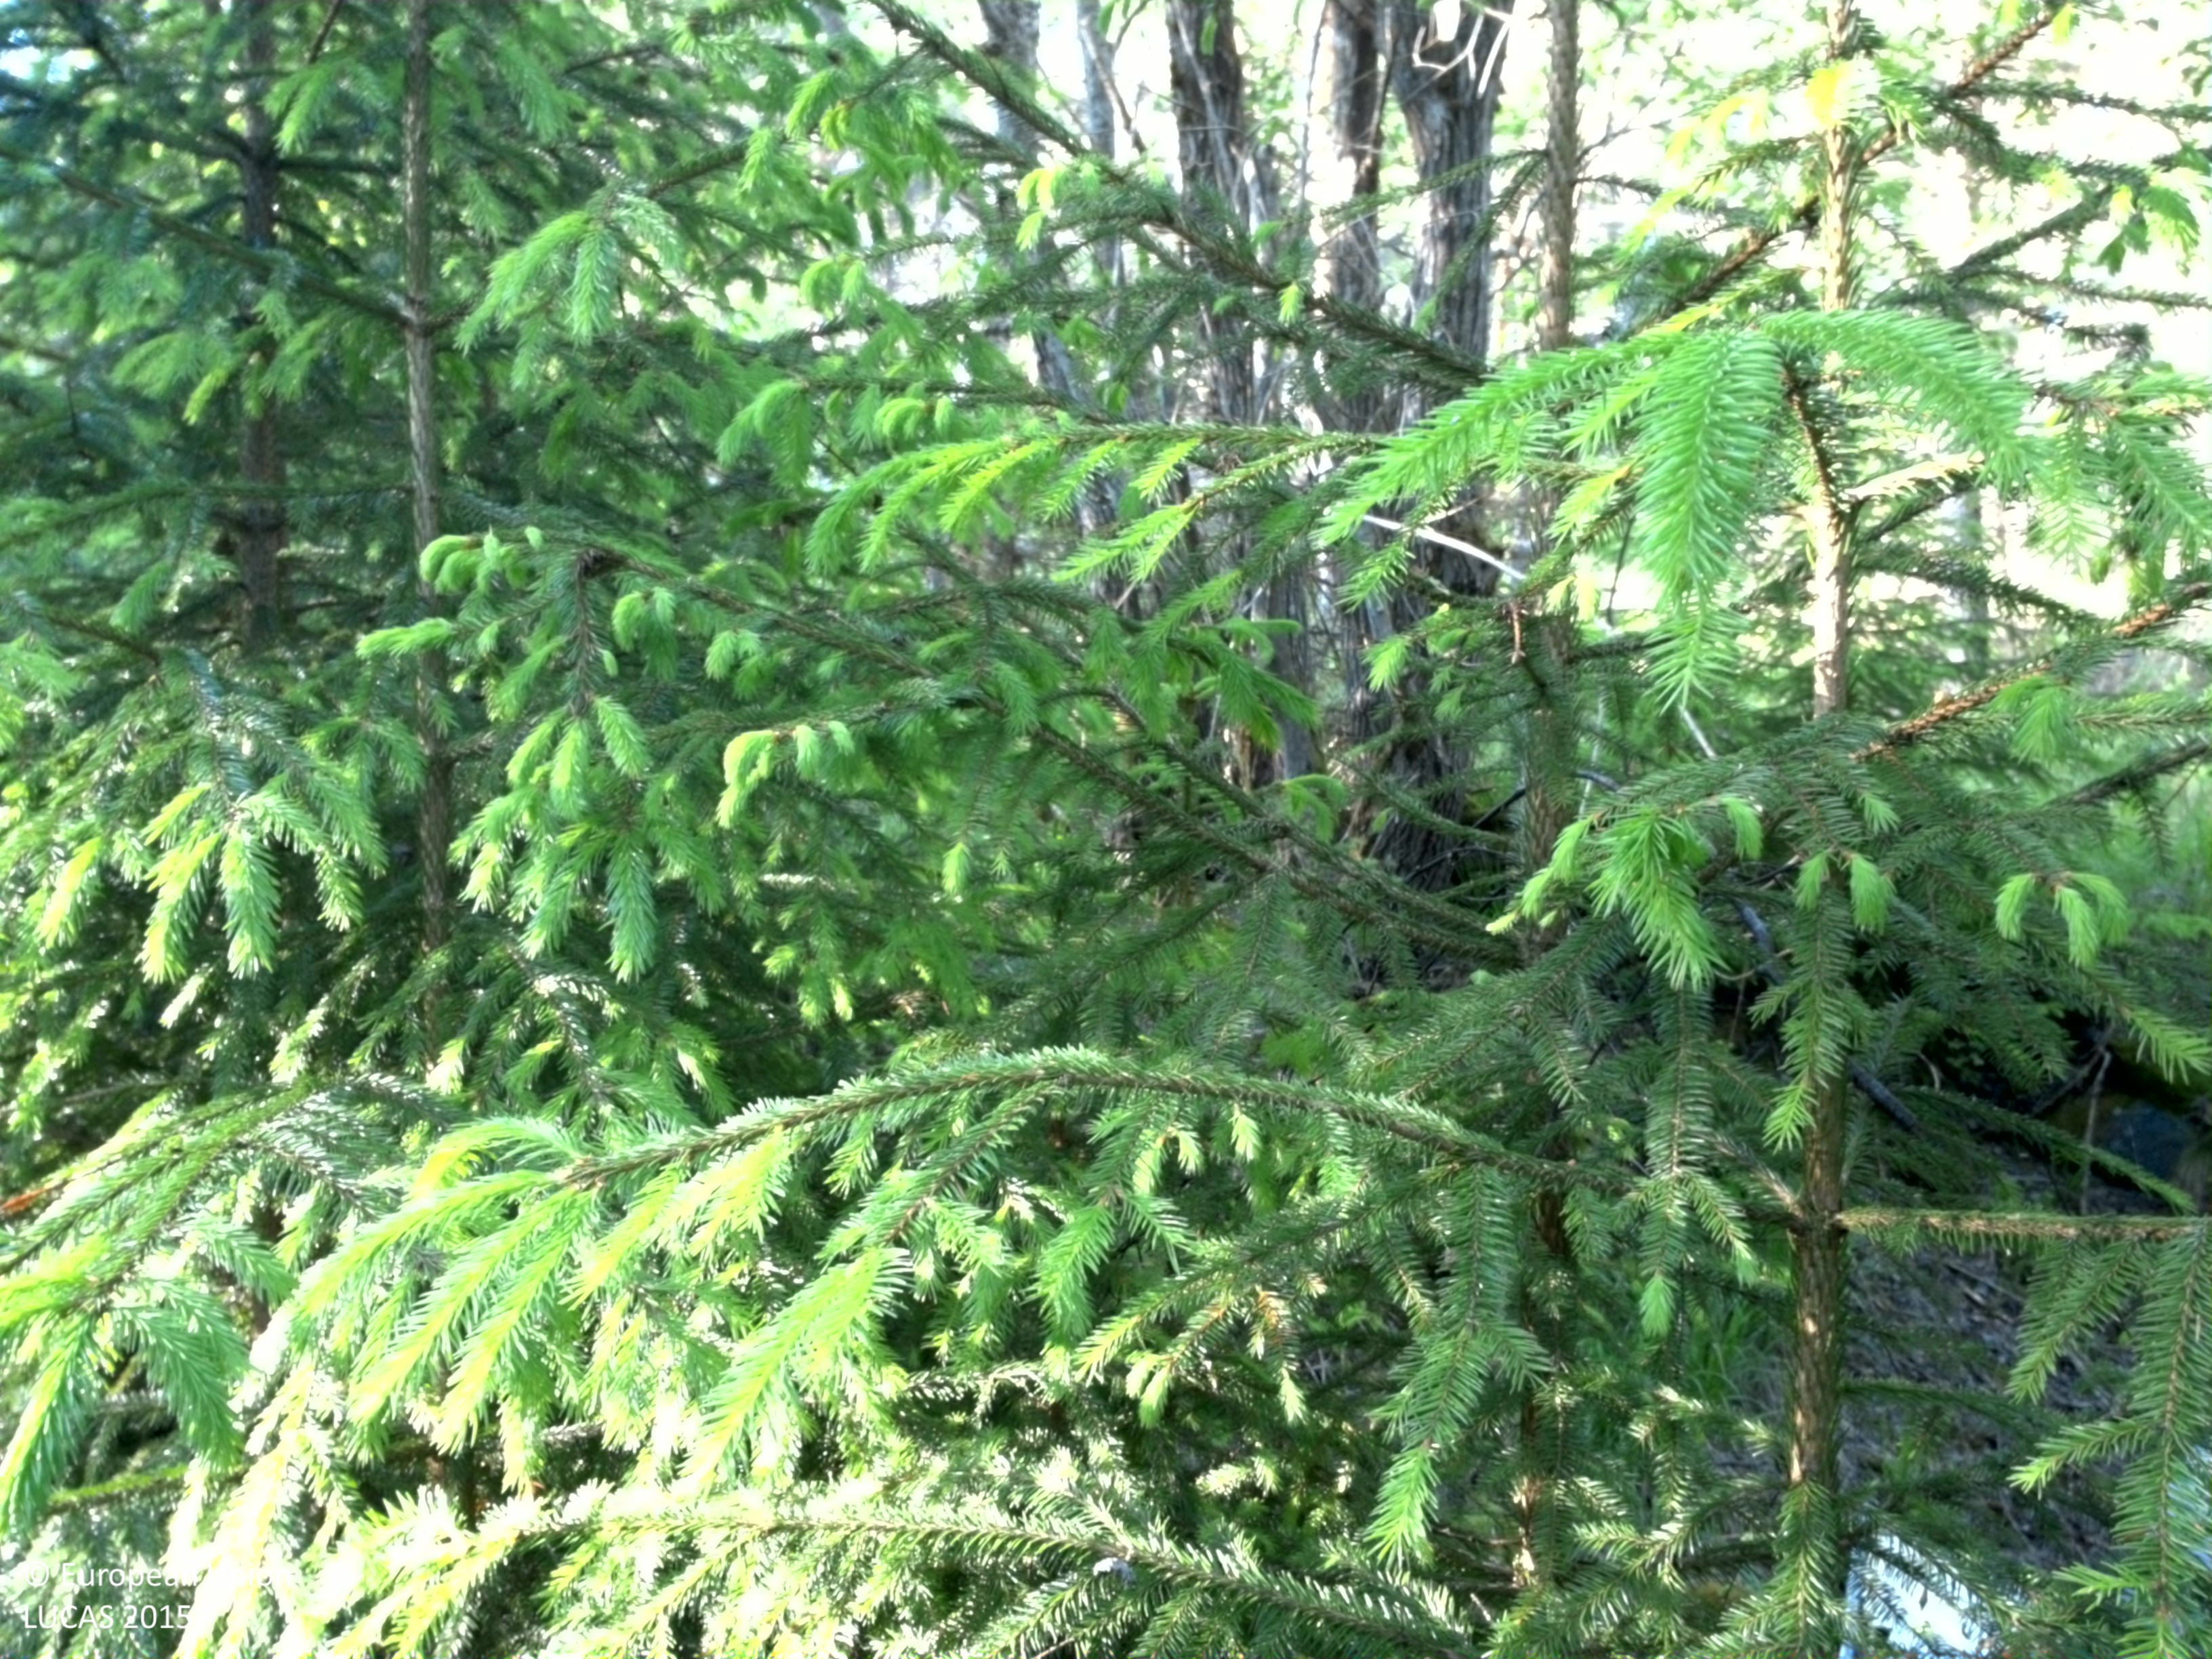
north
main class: Woodland
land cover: Spruce dominated mixed woodland
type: boreal forest
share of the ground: 50 - 75 %
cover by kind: coniferous forest trees 50 %, broadleaved forest trees 25 %, herbaceous plants 20 %, shrubs 5 %
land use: Forestry
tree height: > 5 m
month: June
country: SE
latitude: 58.6636
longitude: 14.5960
